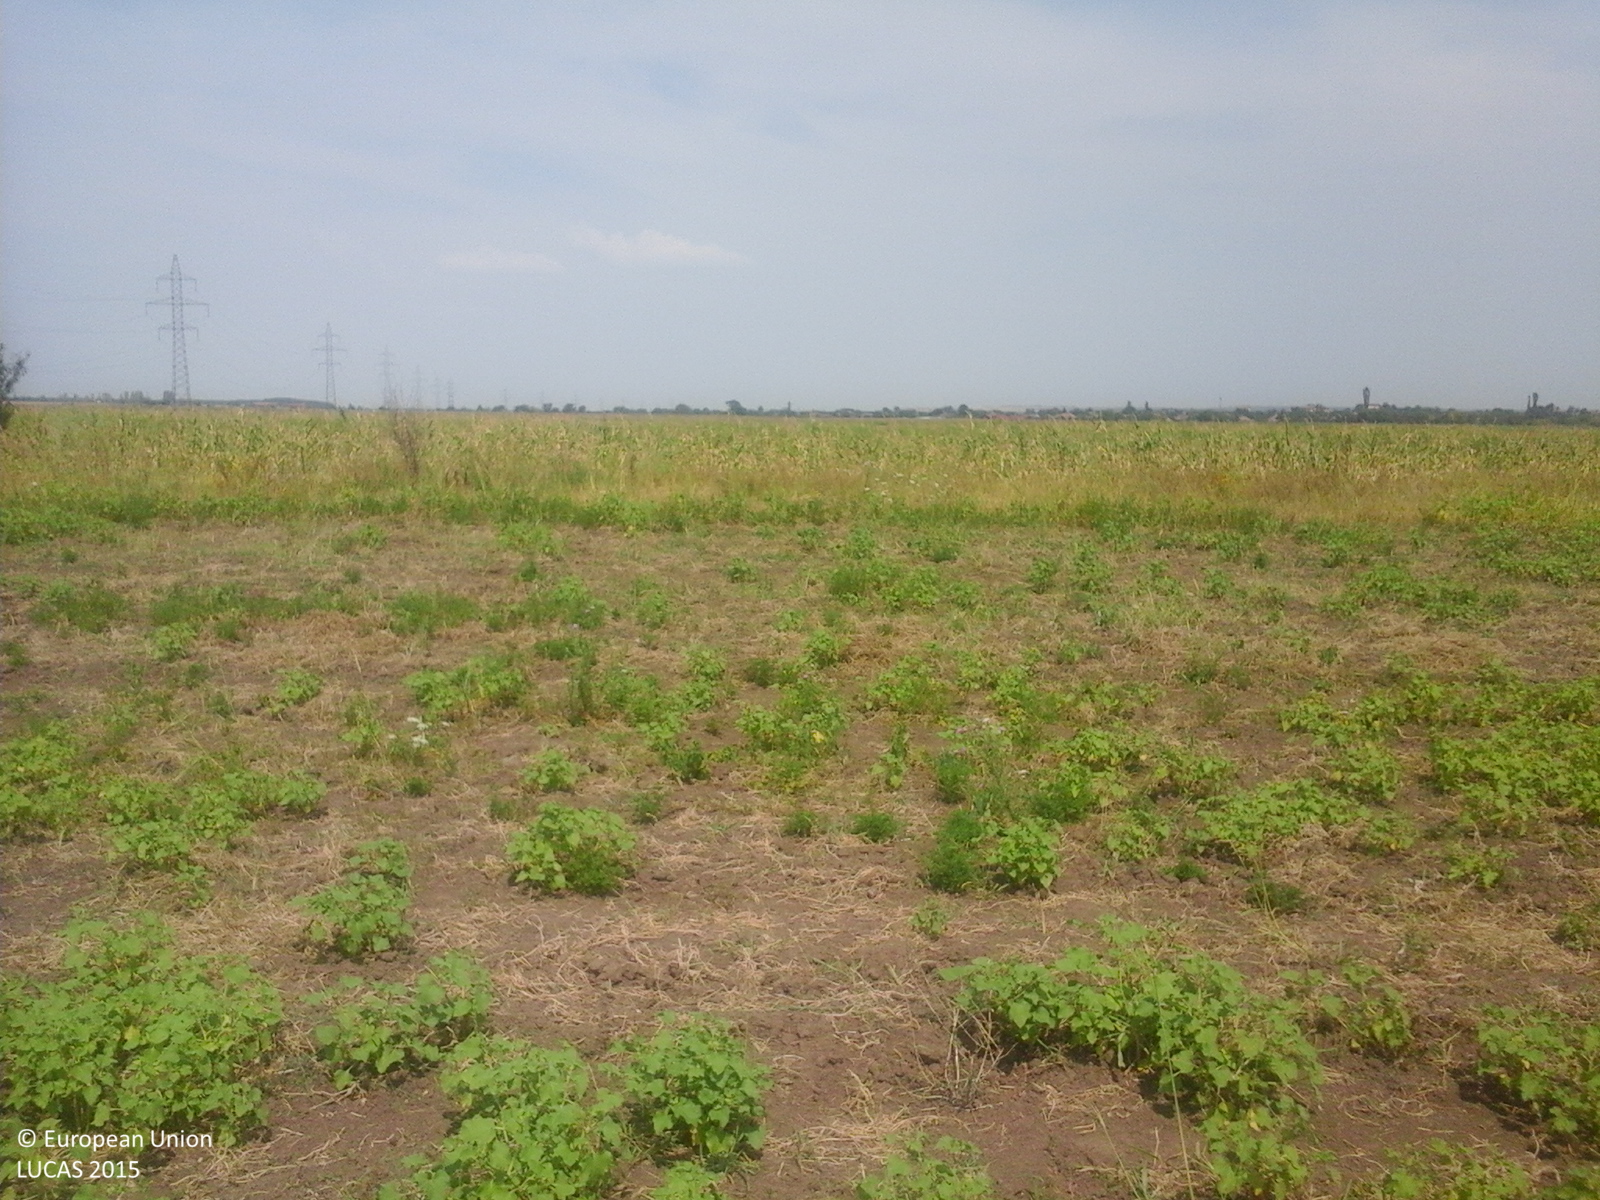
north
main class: Grassland
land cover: Spontaneously vegetated surfaces
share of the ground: > 75 %
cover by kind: herbaceous plants 100 %
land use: Fallow land
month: August
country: RO
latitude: 44.2672
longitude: 22.9332
